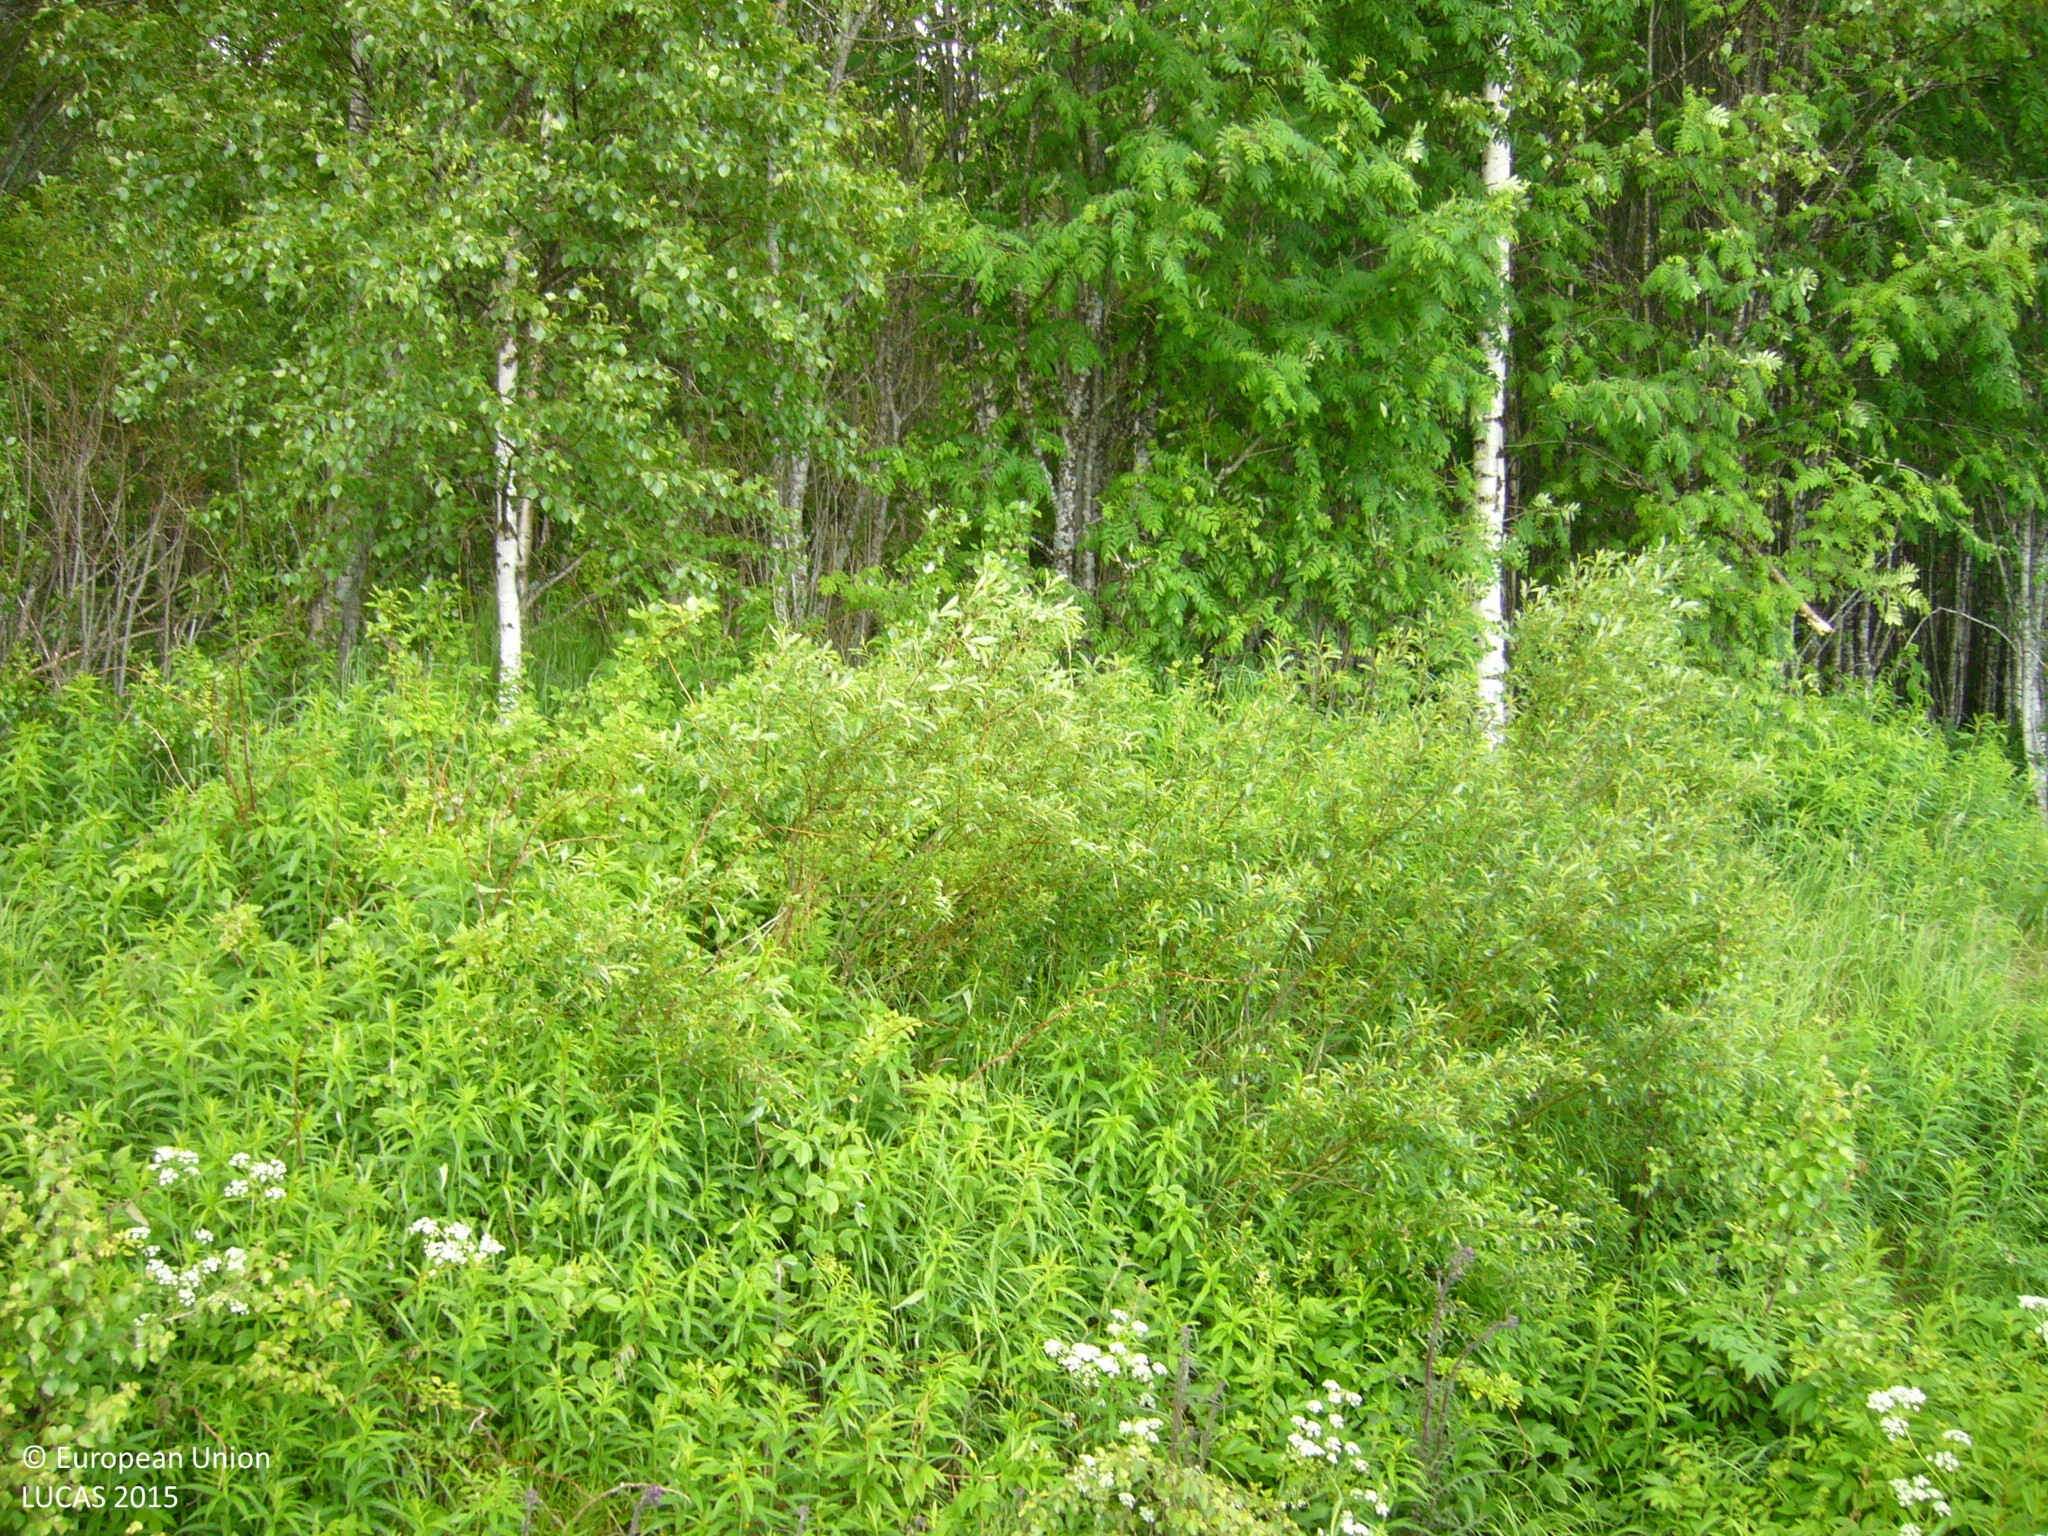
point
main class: Woodland
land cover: Broadleaved woodland
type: boreal forest
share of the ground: > 75 %
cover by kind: broadleaved forest trees 90 %, coniferous forest trees 5 %, shrubs 5 %
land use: Forestry
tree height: > 5 m
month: June
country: FI
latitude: 63.8449
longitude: 26.2818
